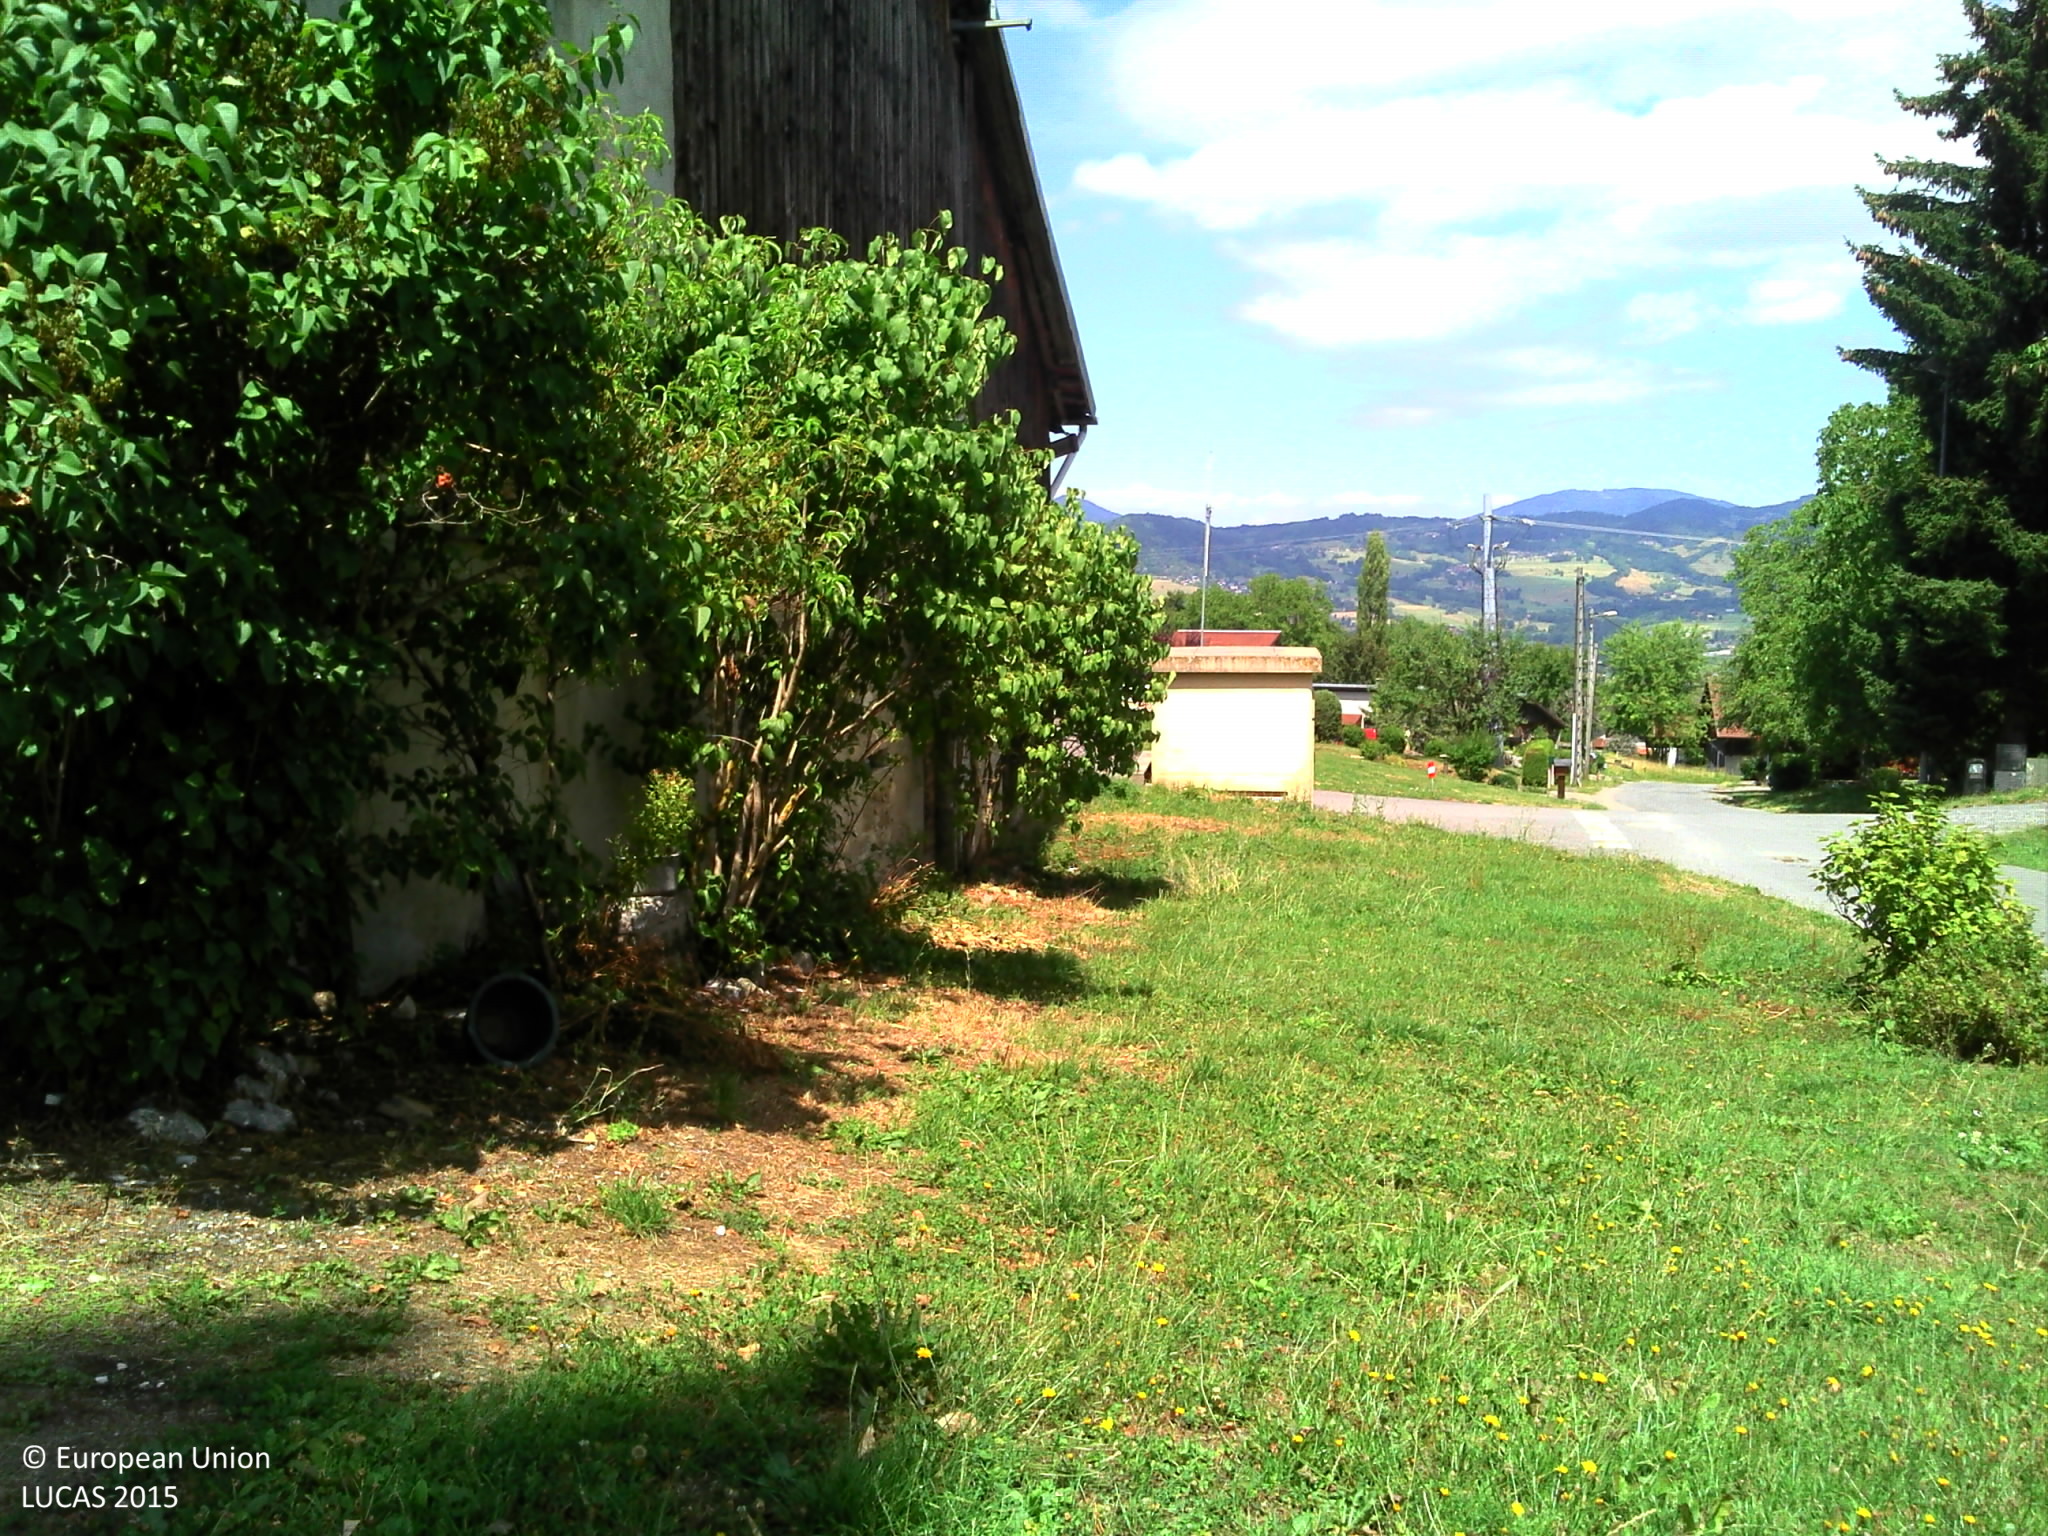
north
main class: Grassland
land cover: Grassland without tree/shrub cover
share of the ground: > 75 %
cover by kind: herbaceous plants 100 %
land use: Residential
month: July
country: FR
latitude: 46.1101
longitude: 6.3939
